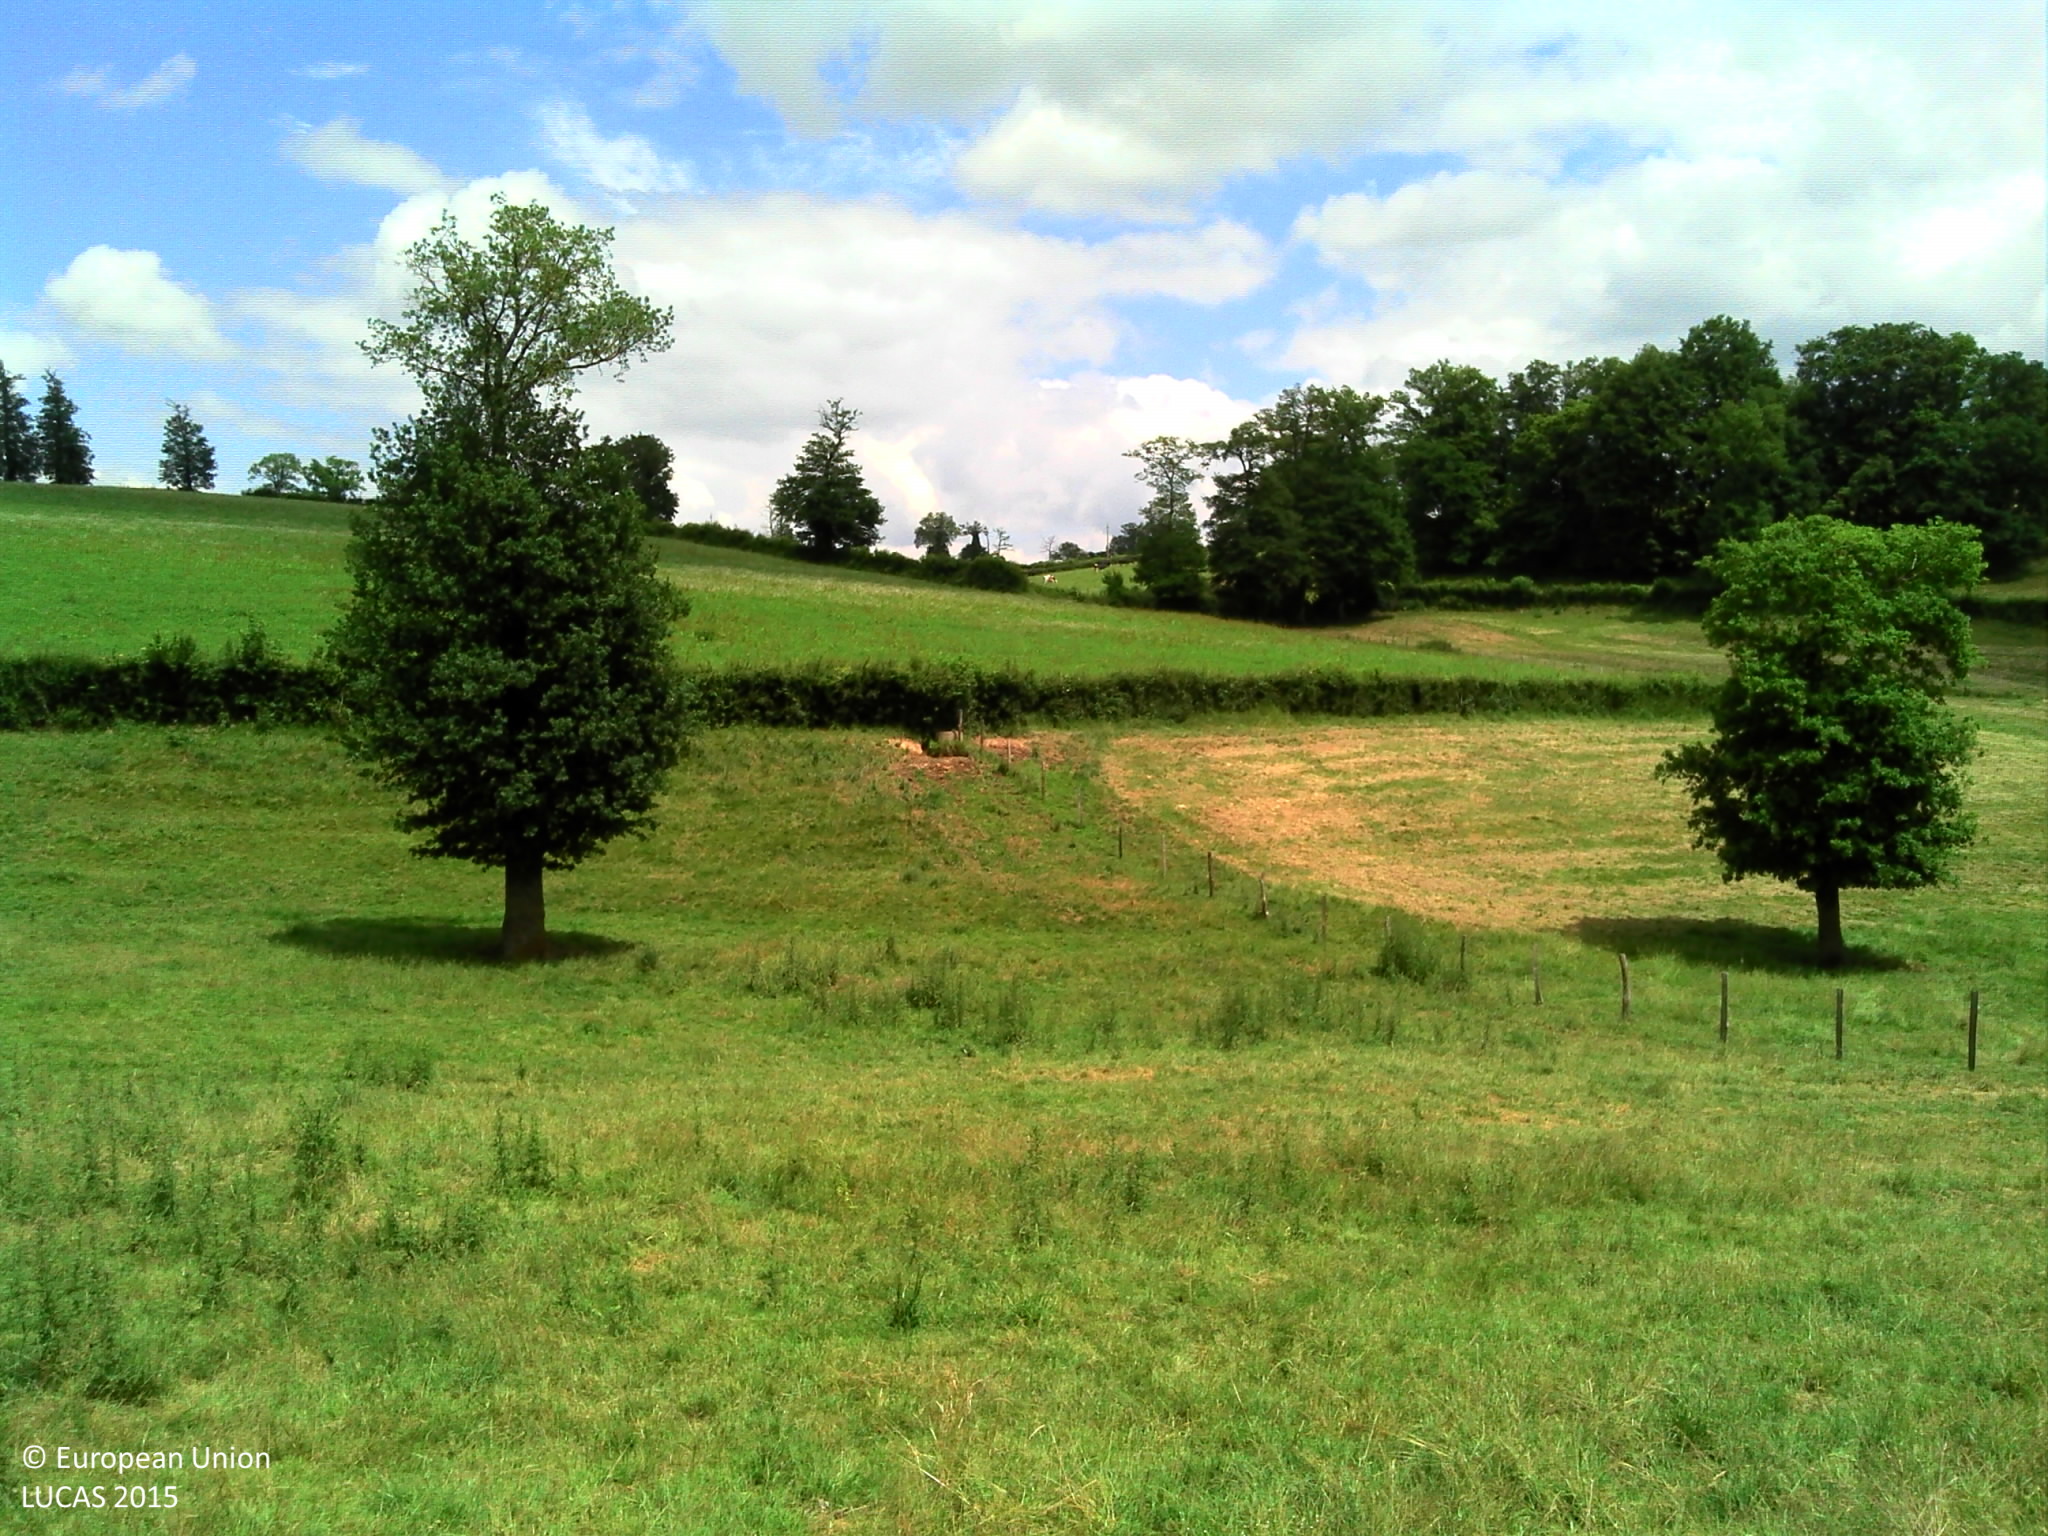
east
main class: Grassland
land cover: Grassland without tree/shrub cover
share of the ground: > 75 %
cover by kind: herbaceous plants 100 %
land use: Agriculture (excluding fallow land and kitchen gardens)
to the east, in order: Grassland without tree/shrub cover; Managed hedges; Fences; Grassland without tree/shrub cover; Fences; Managed hedges; Fences; Grassland without tree/shrub cover; Fences; Grassland with sparse tree/shrub cover; Dry pulses; Grassland without tree/shrub cover; Fences; Grassland without tree/shrub cover
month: June
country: FR
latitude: 44.2780
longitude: 2.4983
